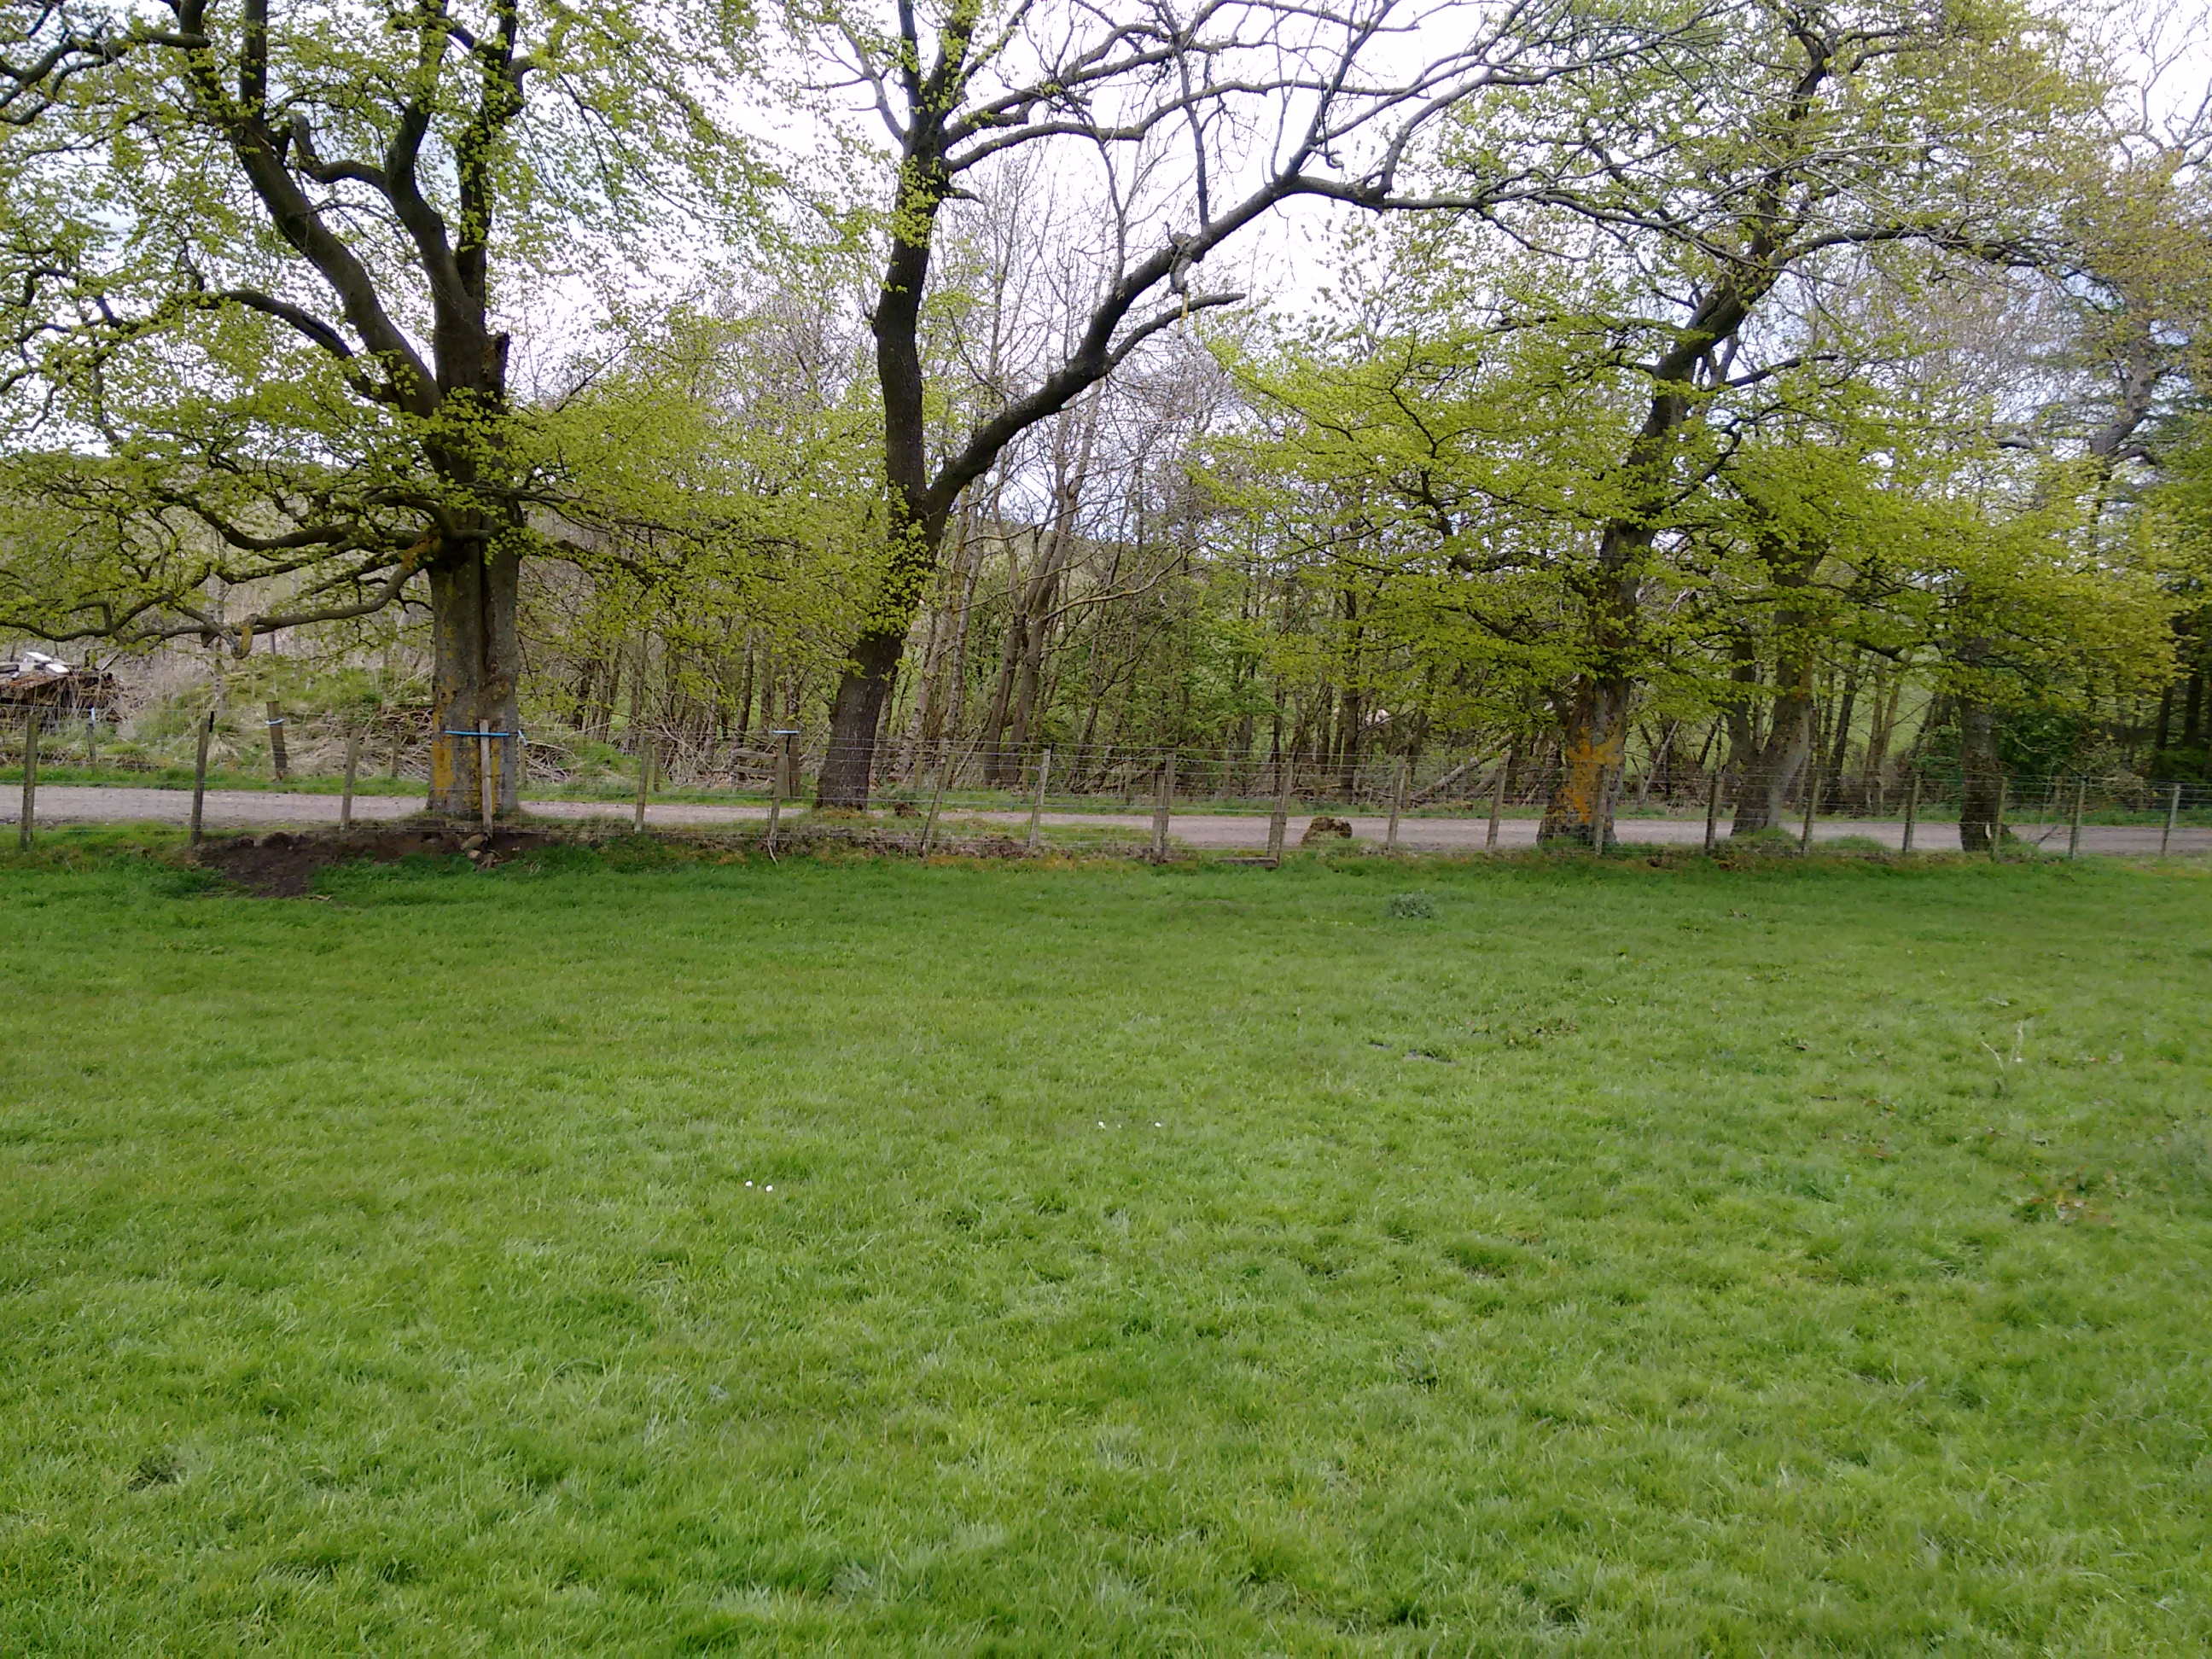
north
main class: Grassland
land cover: Grassland without tree/shrub cover
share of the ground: > 75 %
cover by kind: herbaceous plants 100 %
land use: Agriculture (excluding fallow land and kitchen gardens)
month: May
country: GB
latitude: 55.9022
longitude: -3.7252
